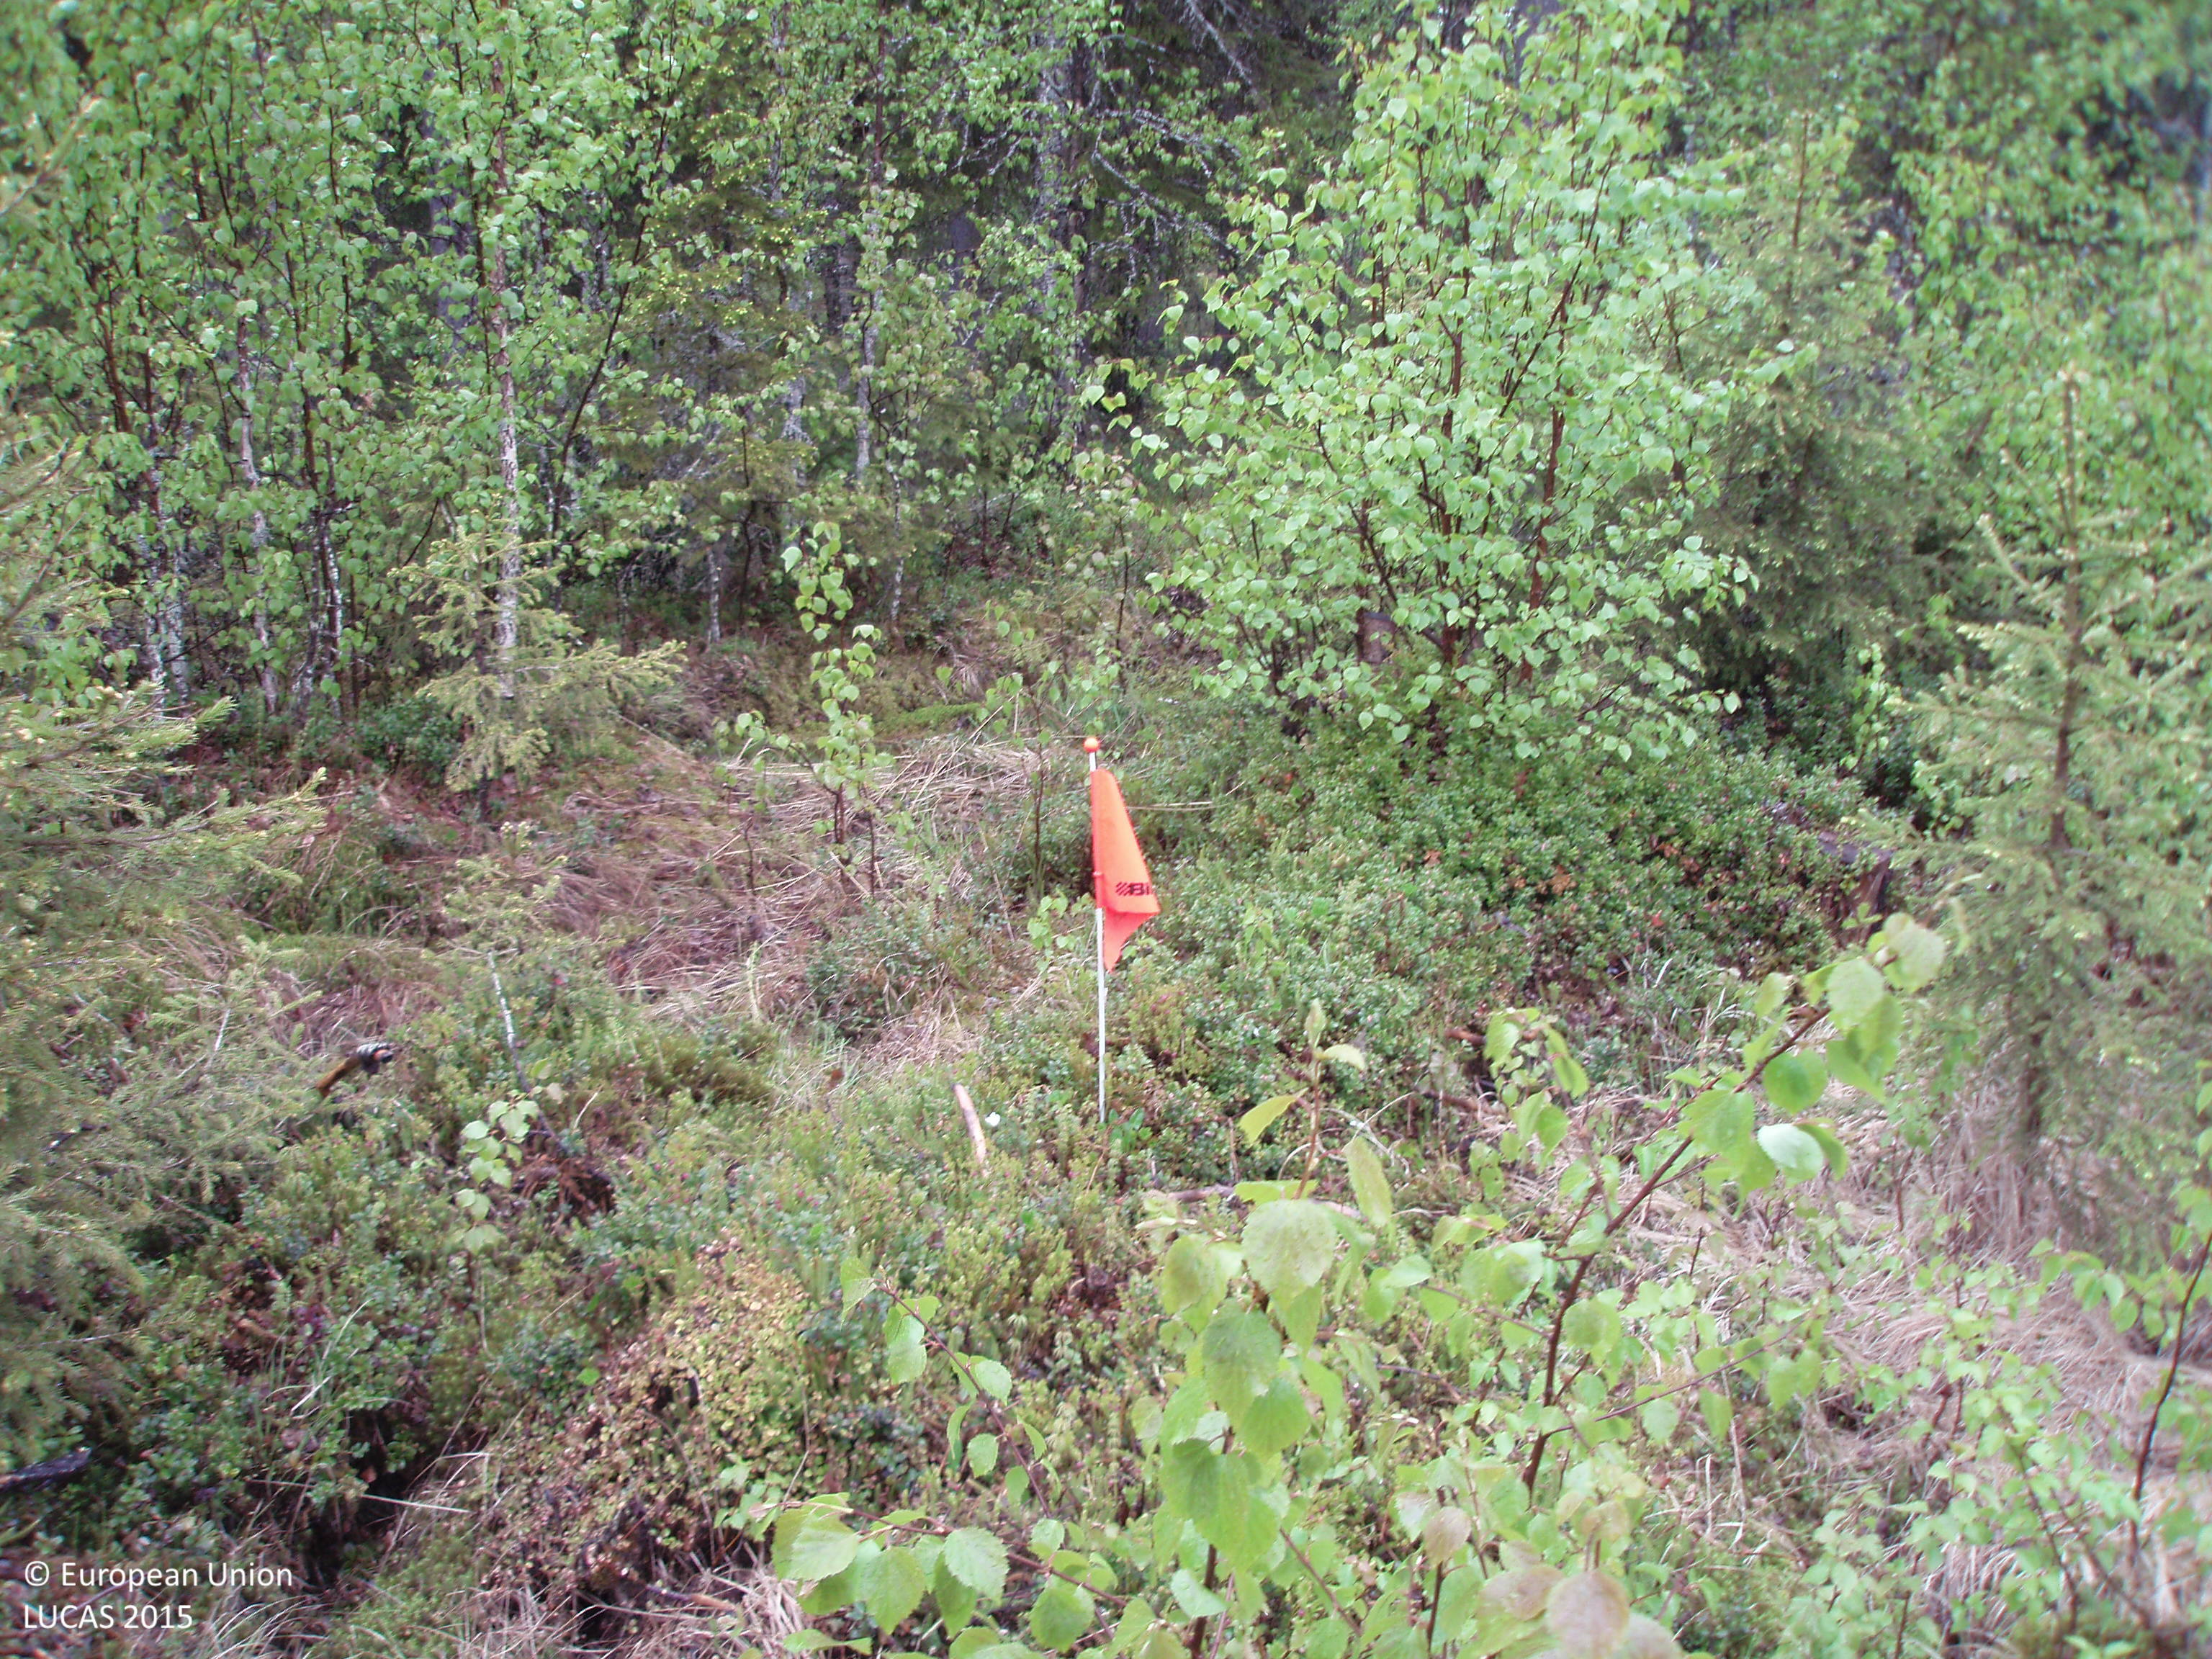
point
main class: Woodland
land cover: Other mixed woodland
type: boreal forest
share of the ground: > 75 %
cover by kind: broadleaved forest trees 60 %, coniferous forest trees 25 %, shrubs 10 %, herbaceous plants 5 %
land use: Forestry
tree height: < 5 m
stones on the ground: < 10 %
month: June
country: FI
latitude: 67.4293
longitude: 26.4851
